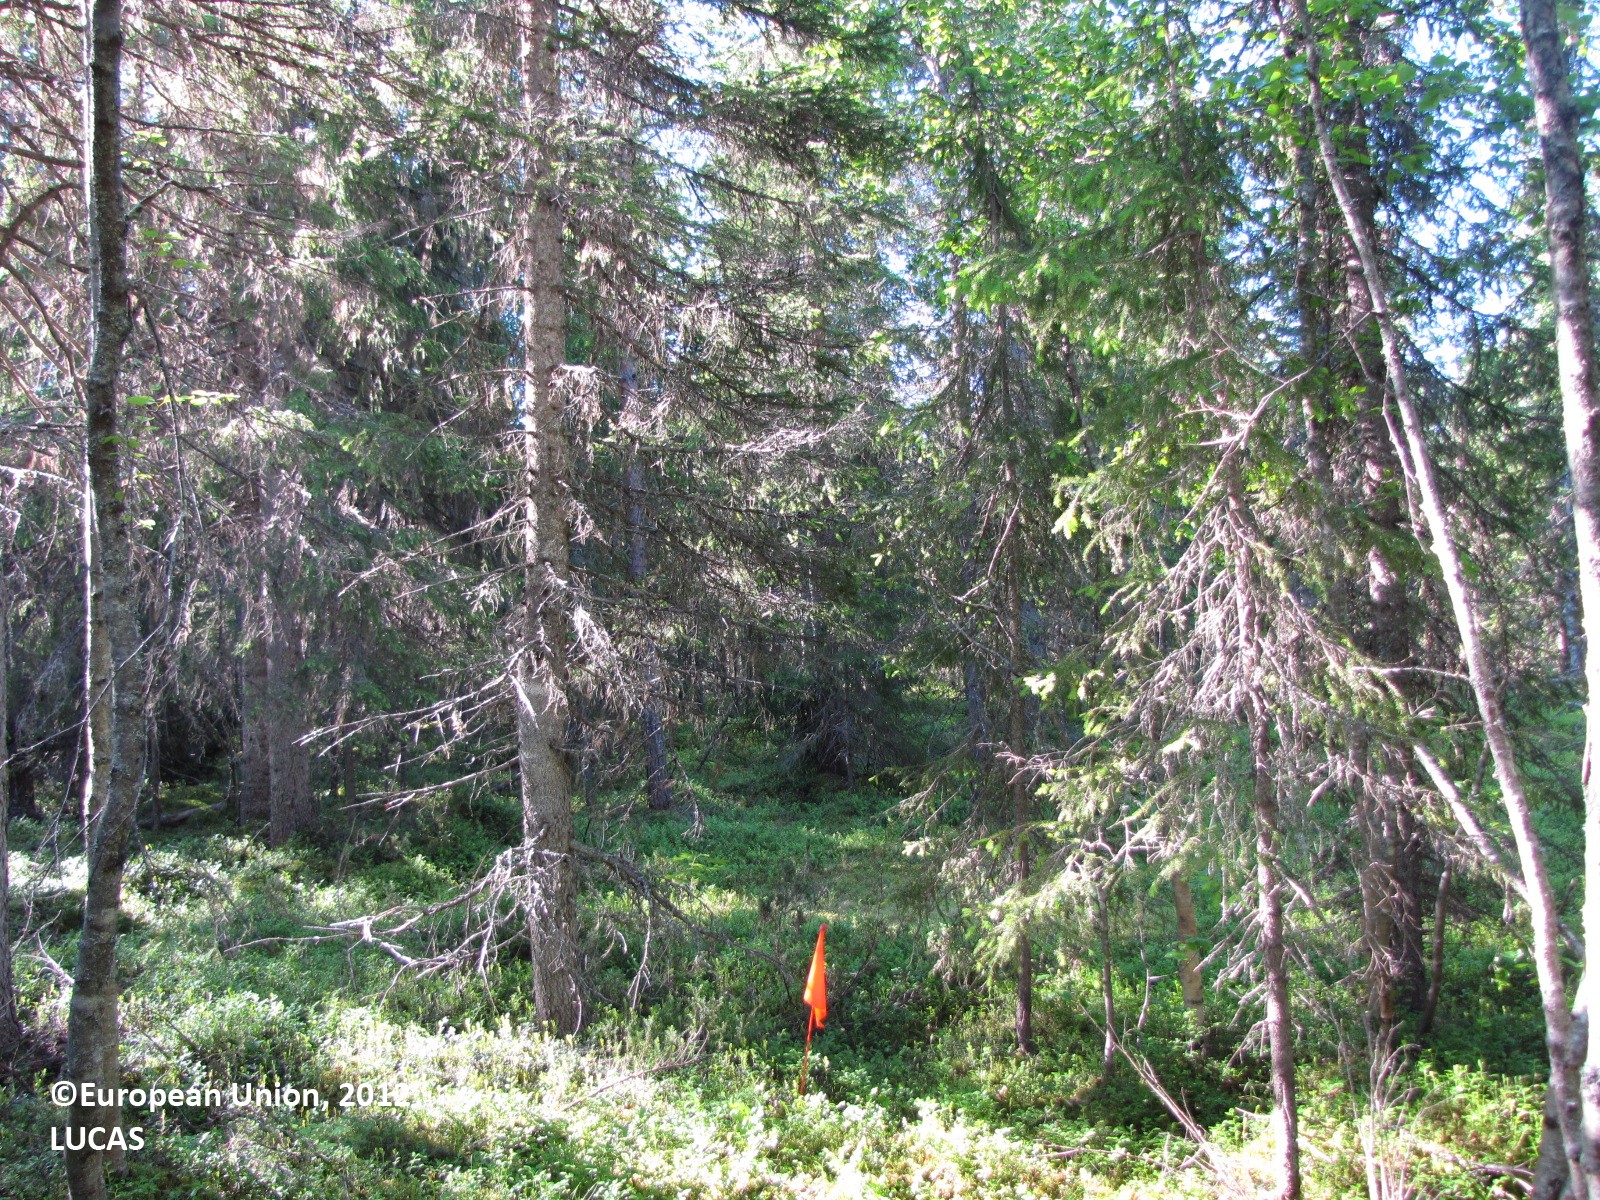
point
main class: Woodland
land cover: Spruce dominated coniferous woodland
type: boreal forest
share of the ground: 50 - 75 %
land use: Forestry
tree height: > 5 m
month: July
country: FI
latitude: 66.4170
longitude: 24.7670
